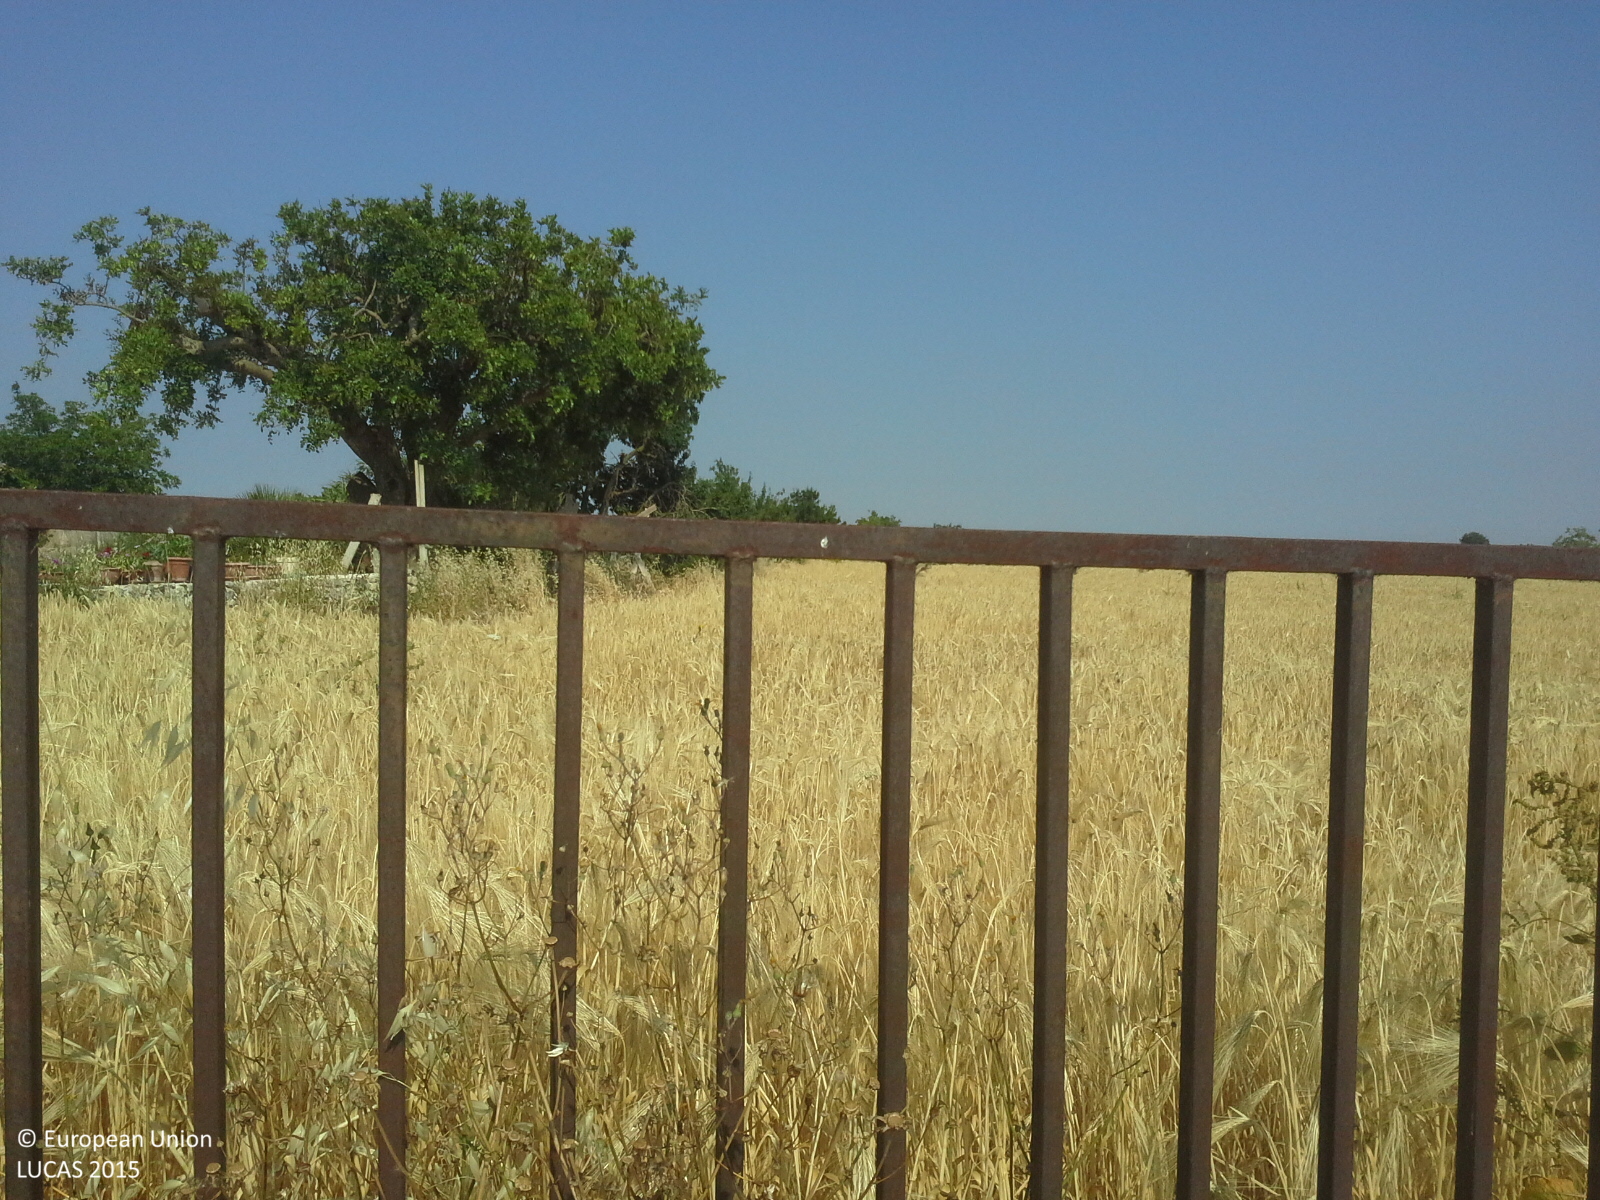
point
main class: Cropland
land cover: Durum wheat
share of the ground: > 75 %
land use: Agriculture (excluding fallow land and kitchen gardens)
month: June
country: IT
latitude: 36.8591
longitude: 14.8628
